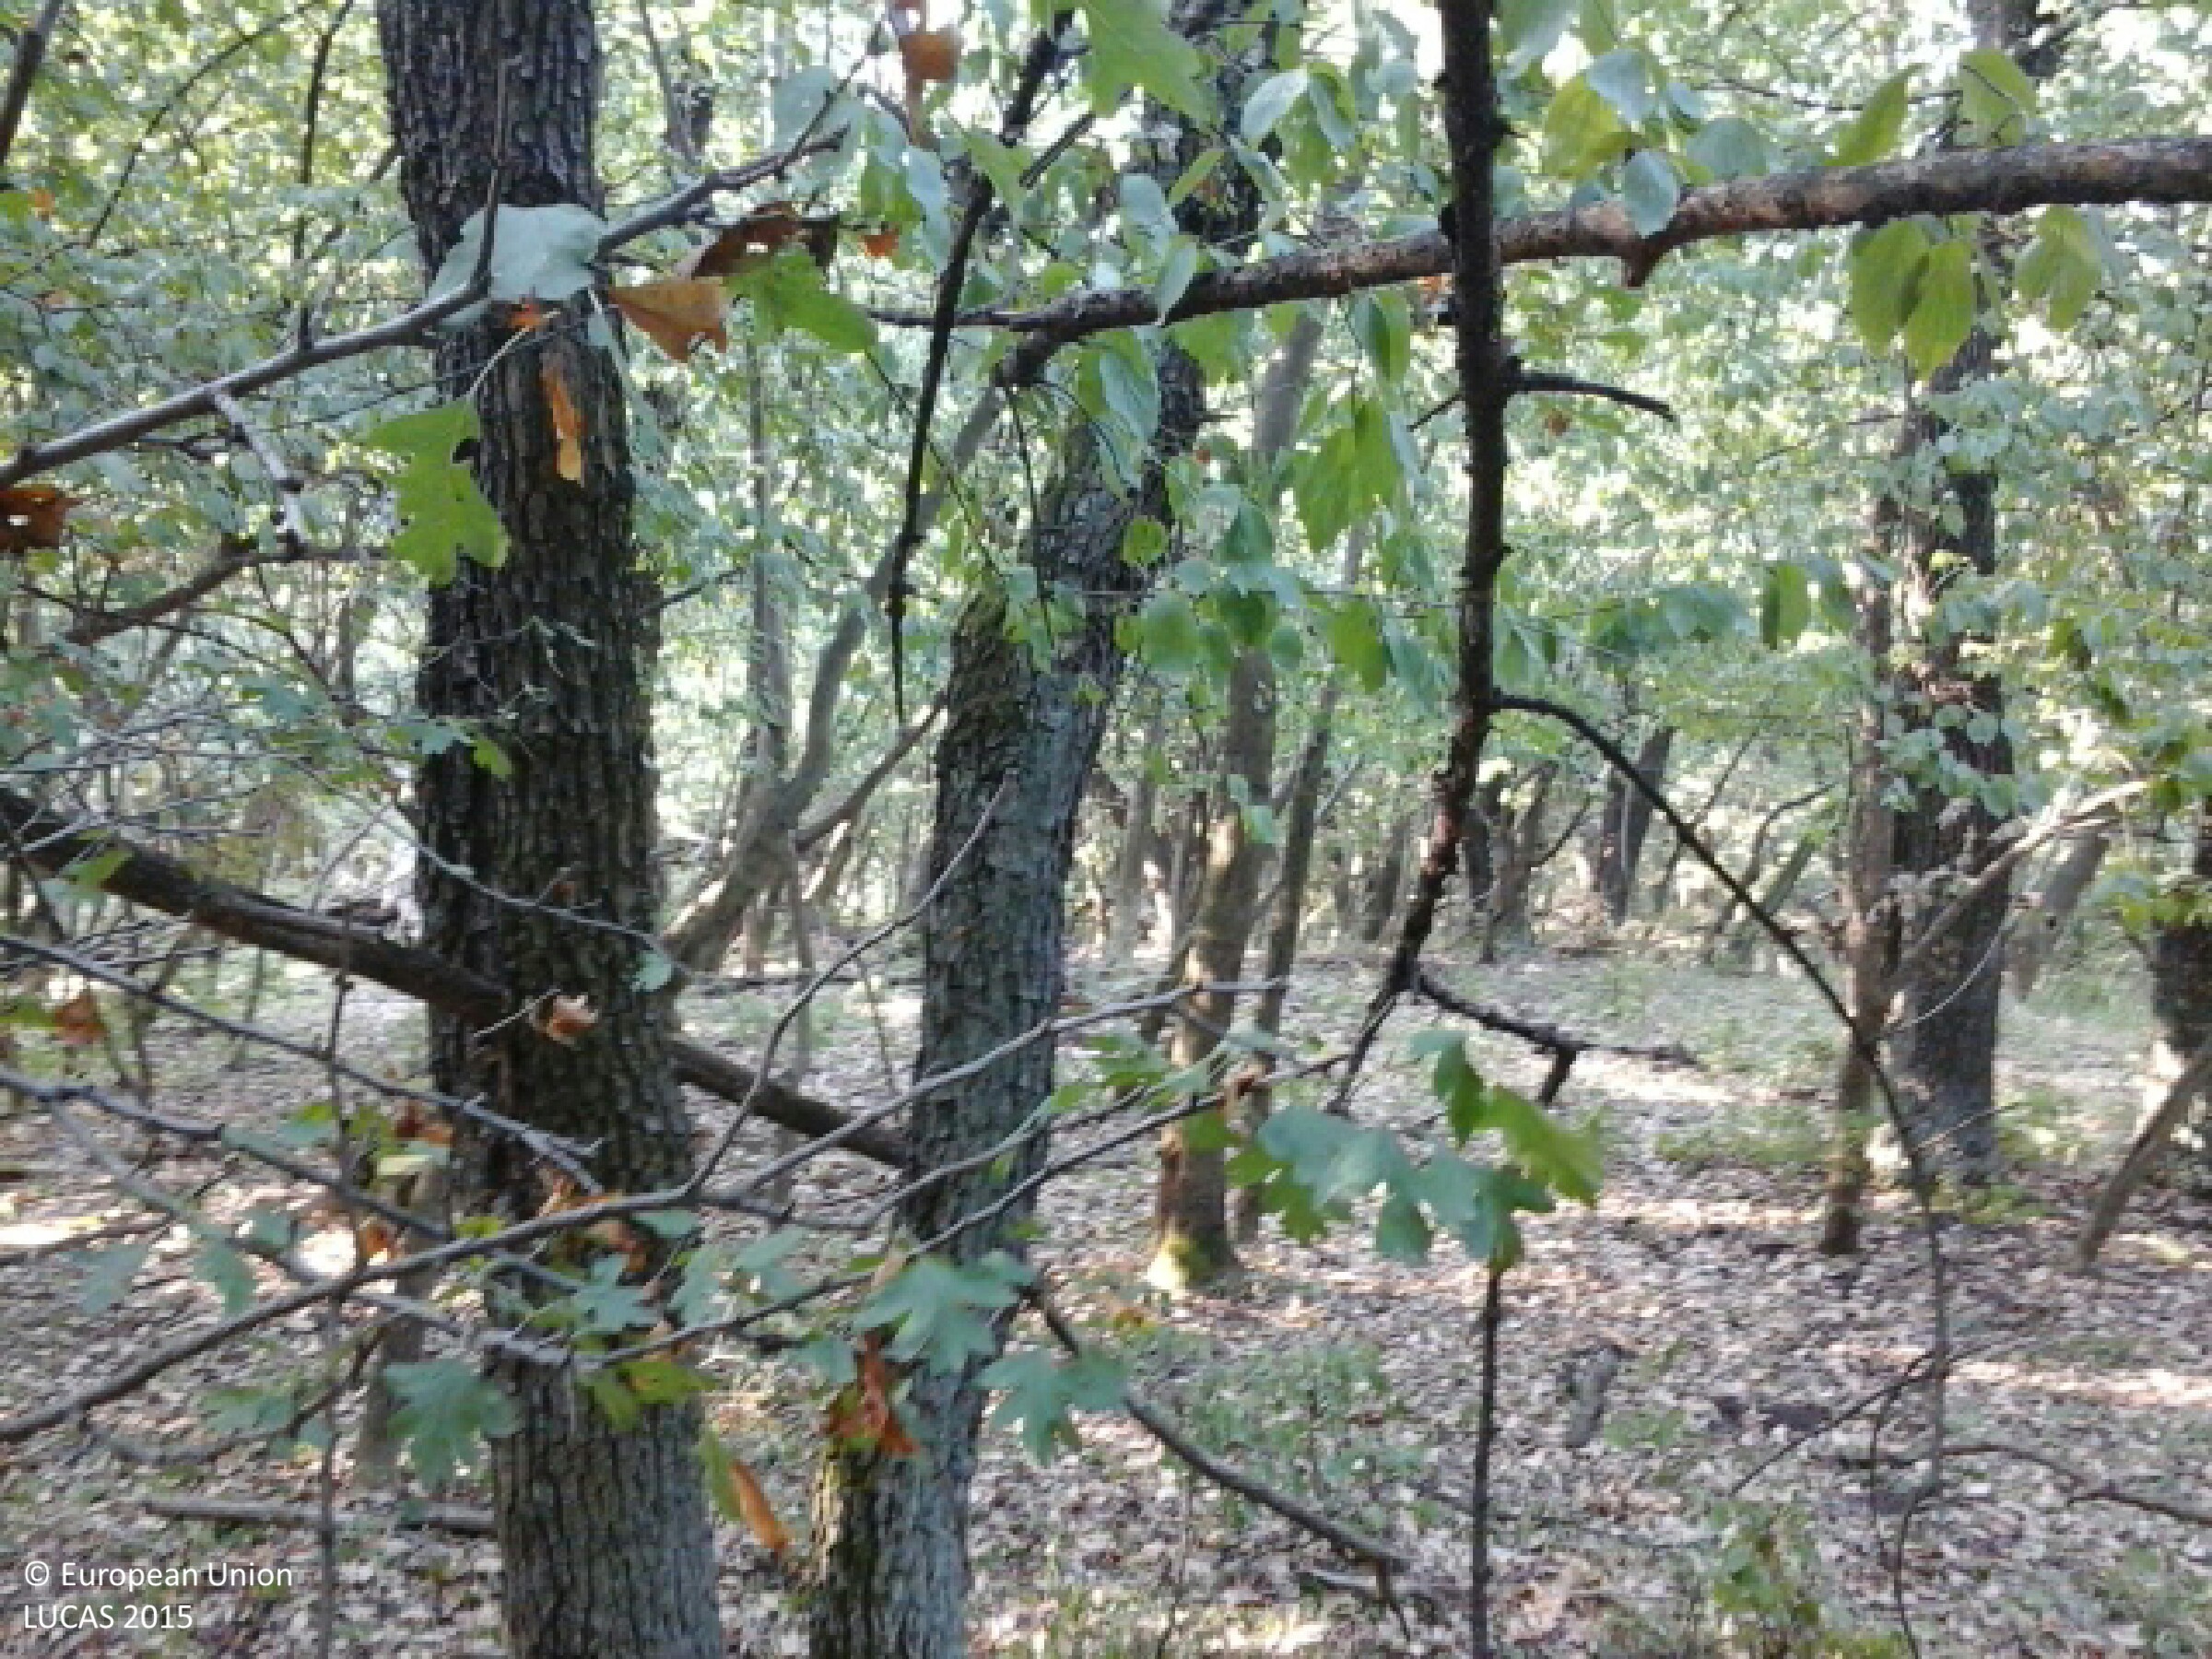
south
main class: Woodland
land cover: Broadleaved woodland
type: mesophytic deciduous forest
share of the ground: > 75 %
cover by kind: broadleaved forest trees 95 %, shrubs 5 %
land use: Forestry
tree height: > 5 m
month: August
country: HU
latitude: 47.4950
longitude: 18.5226
